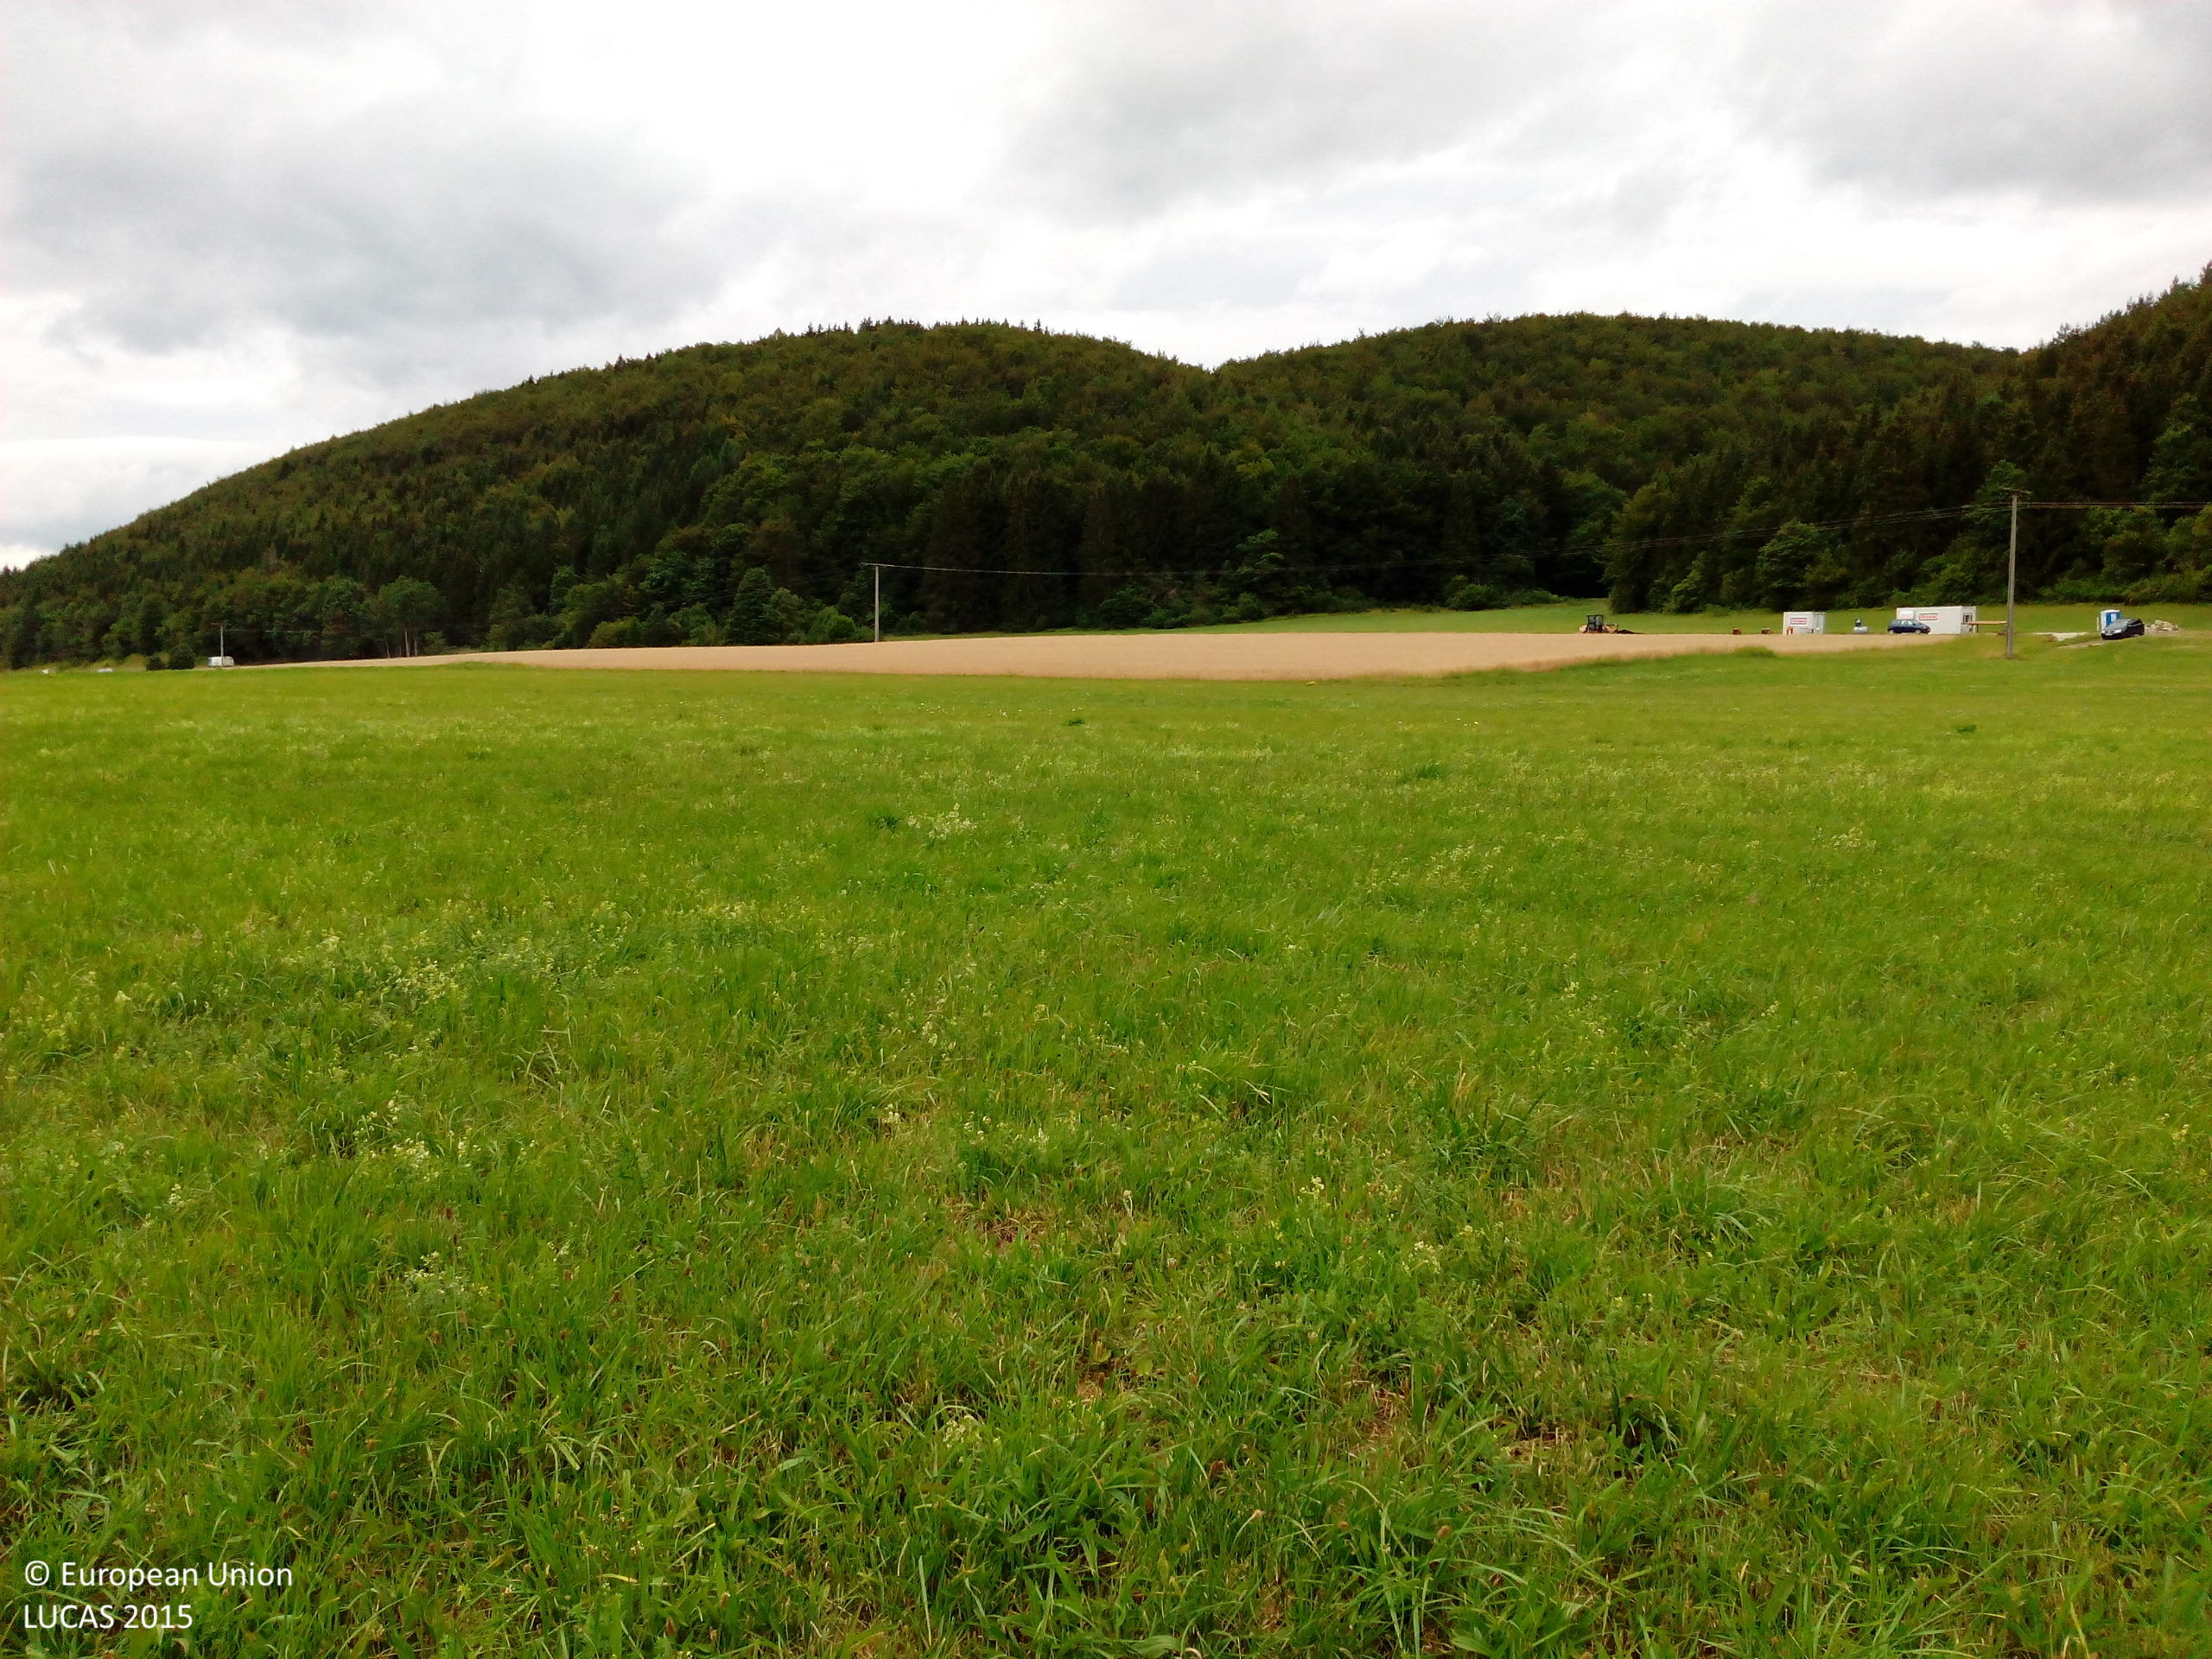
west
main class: Grassland
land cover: Grassland without tree/shrub cover
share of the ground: > 75 %
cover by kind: herbaceous plants 95 %, unconsolidated bare surface 5 %
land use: Agriculture (excluding fallow land and kitchen gardens)
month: July
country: DE
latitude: 47.8546
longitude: 8.5976
